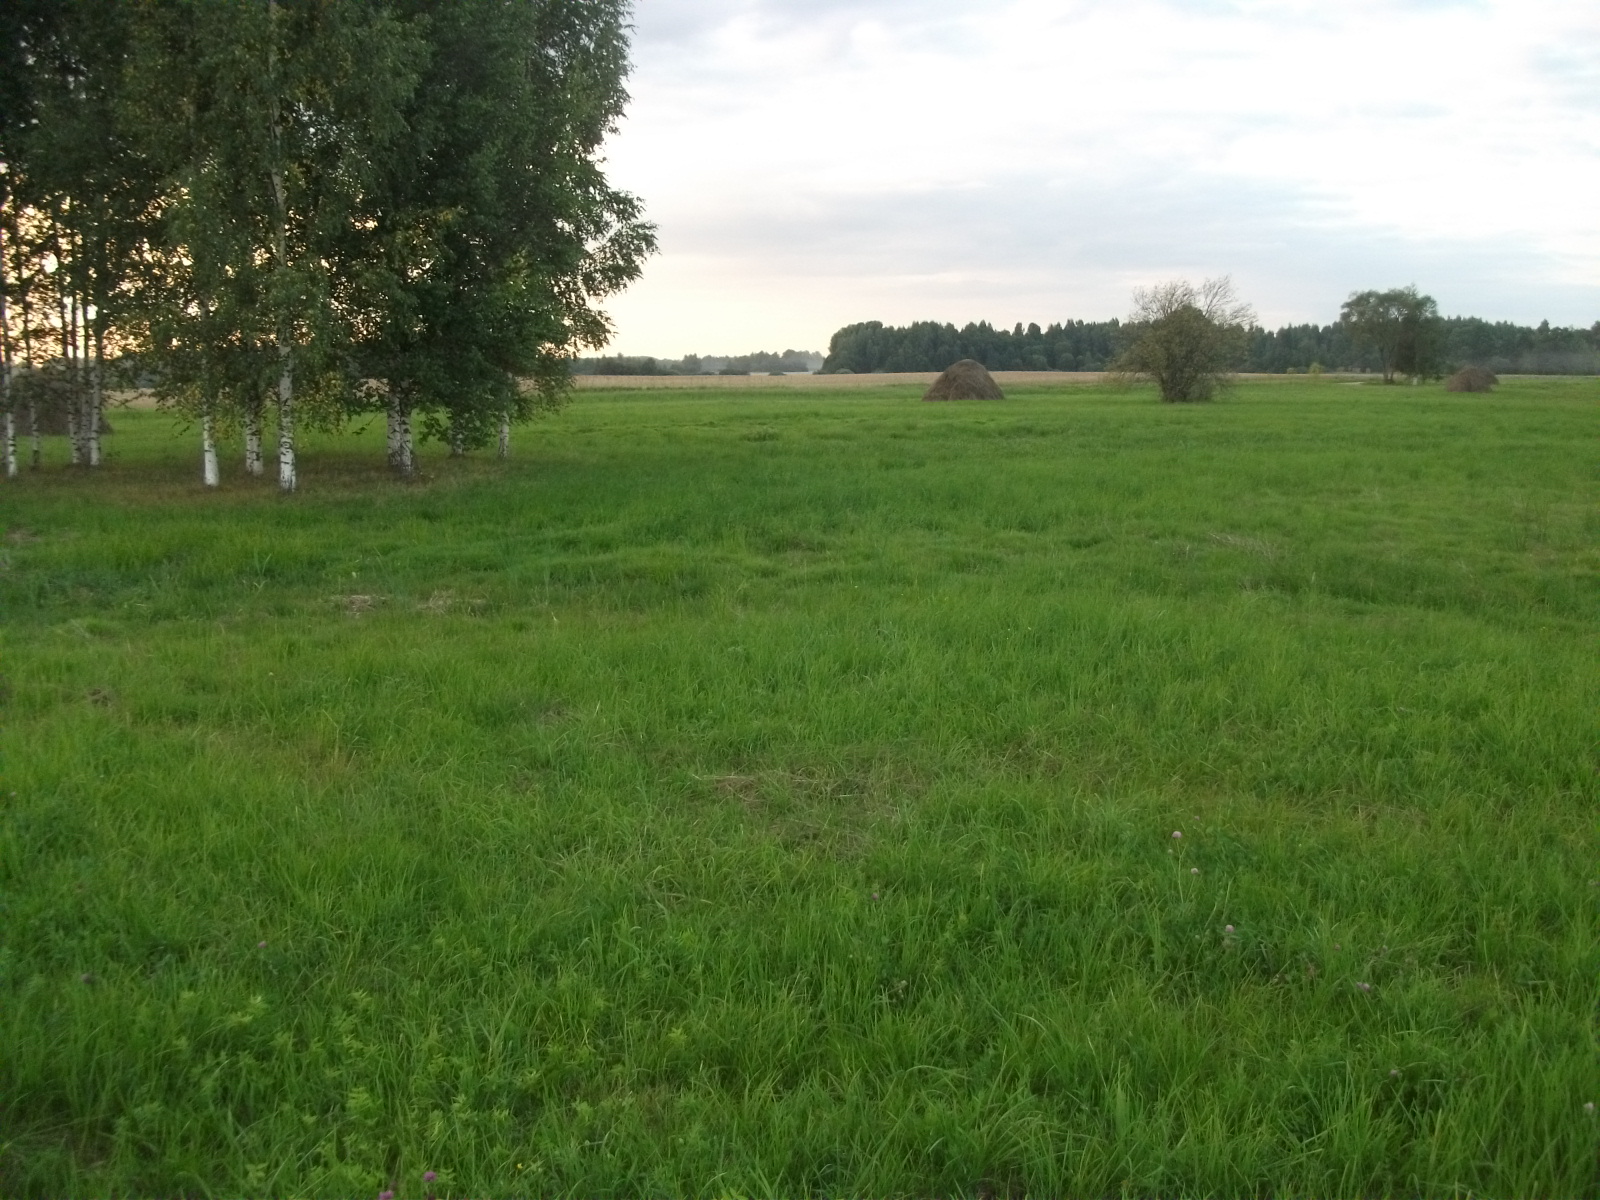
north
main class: Grassland
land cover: Grassland without tree/shrub cover
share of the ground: > 75 %
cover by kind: herbaceous plants 100 %
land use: Agriculture (excluding fallow land and kitchen gardens)
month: August
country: LV
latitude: 56.7446
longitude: 26.5142
